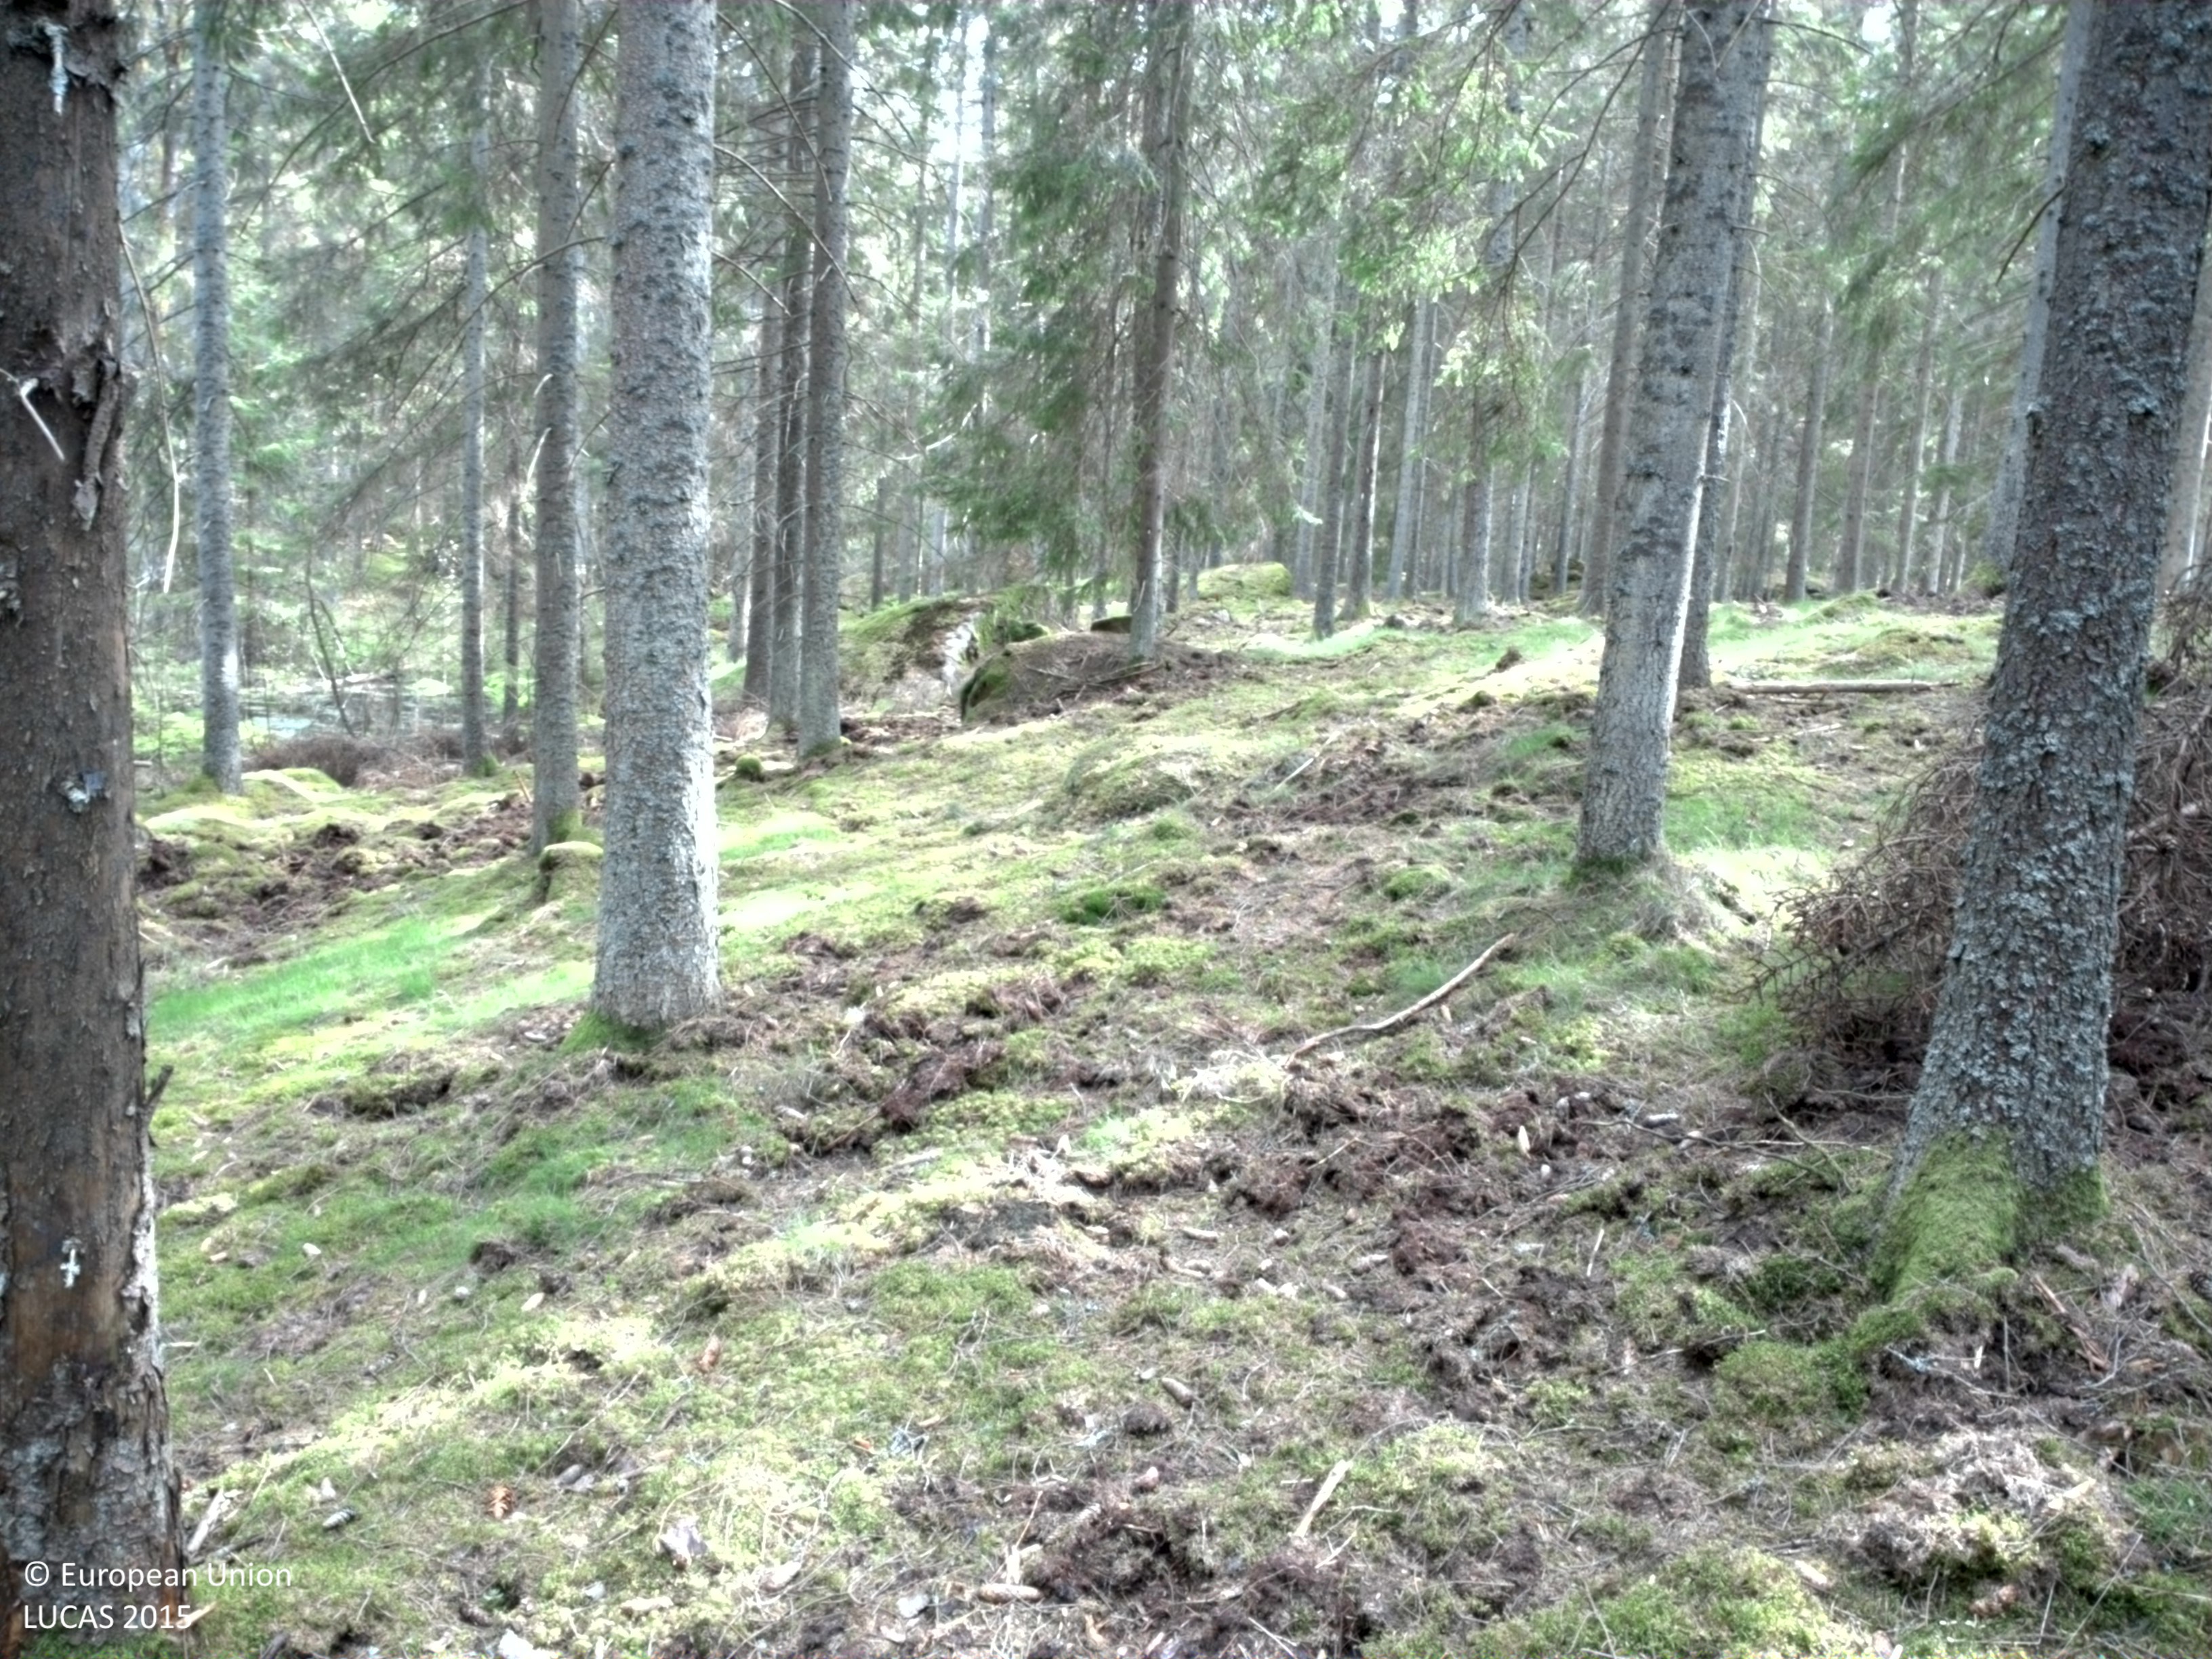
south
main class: Woodland
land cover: Spruce dominated coniferous woodland
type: boreal forest
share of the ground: > 75 %
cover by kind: coniferous forest trees 90 %, lichens and mosses 10 %
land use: Forestry
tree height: > 5 m
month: May
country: SE
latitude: 56.4343
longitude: 15.8219
